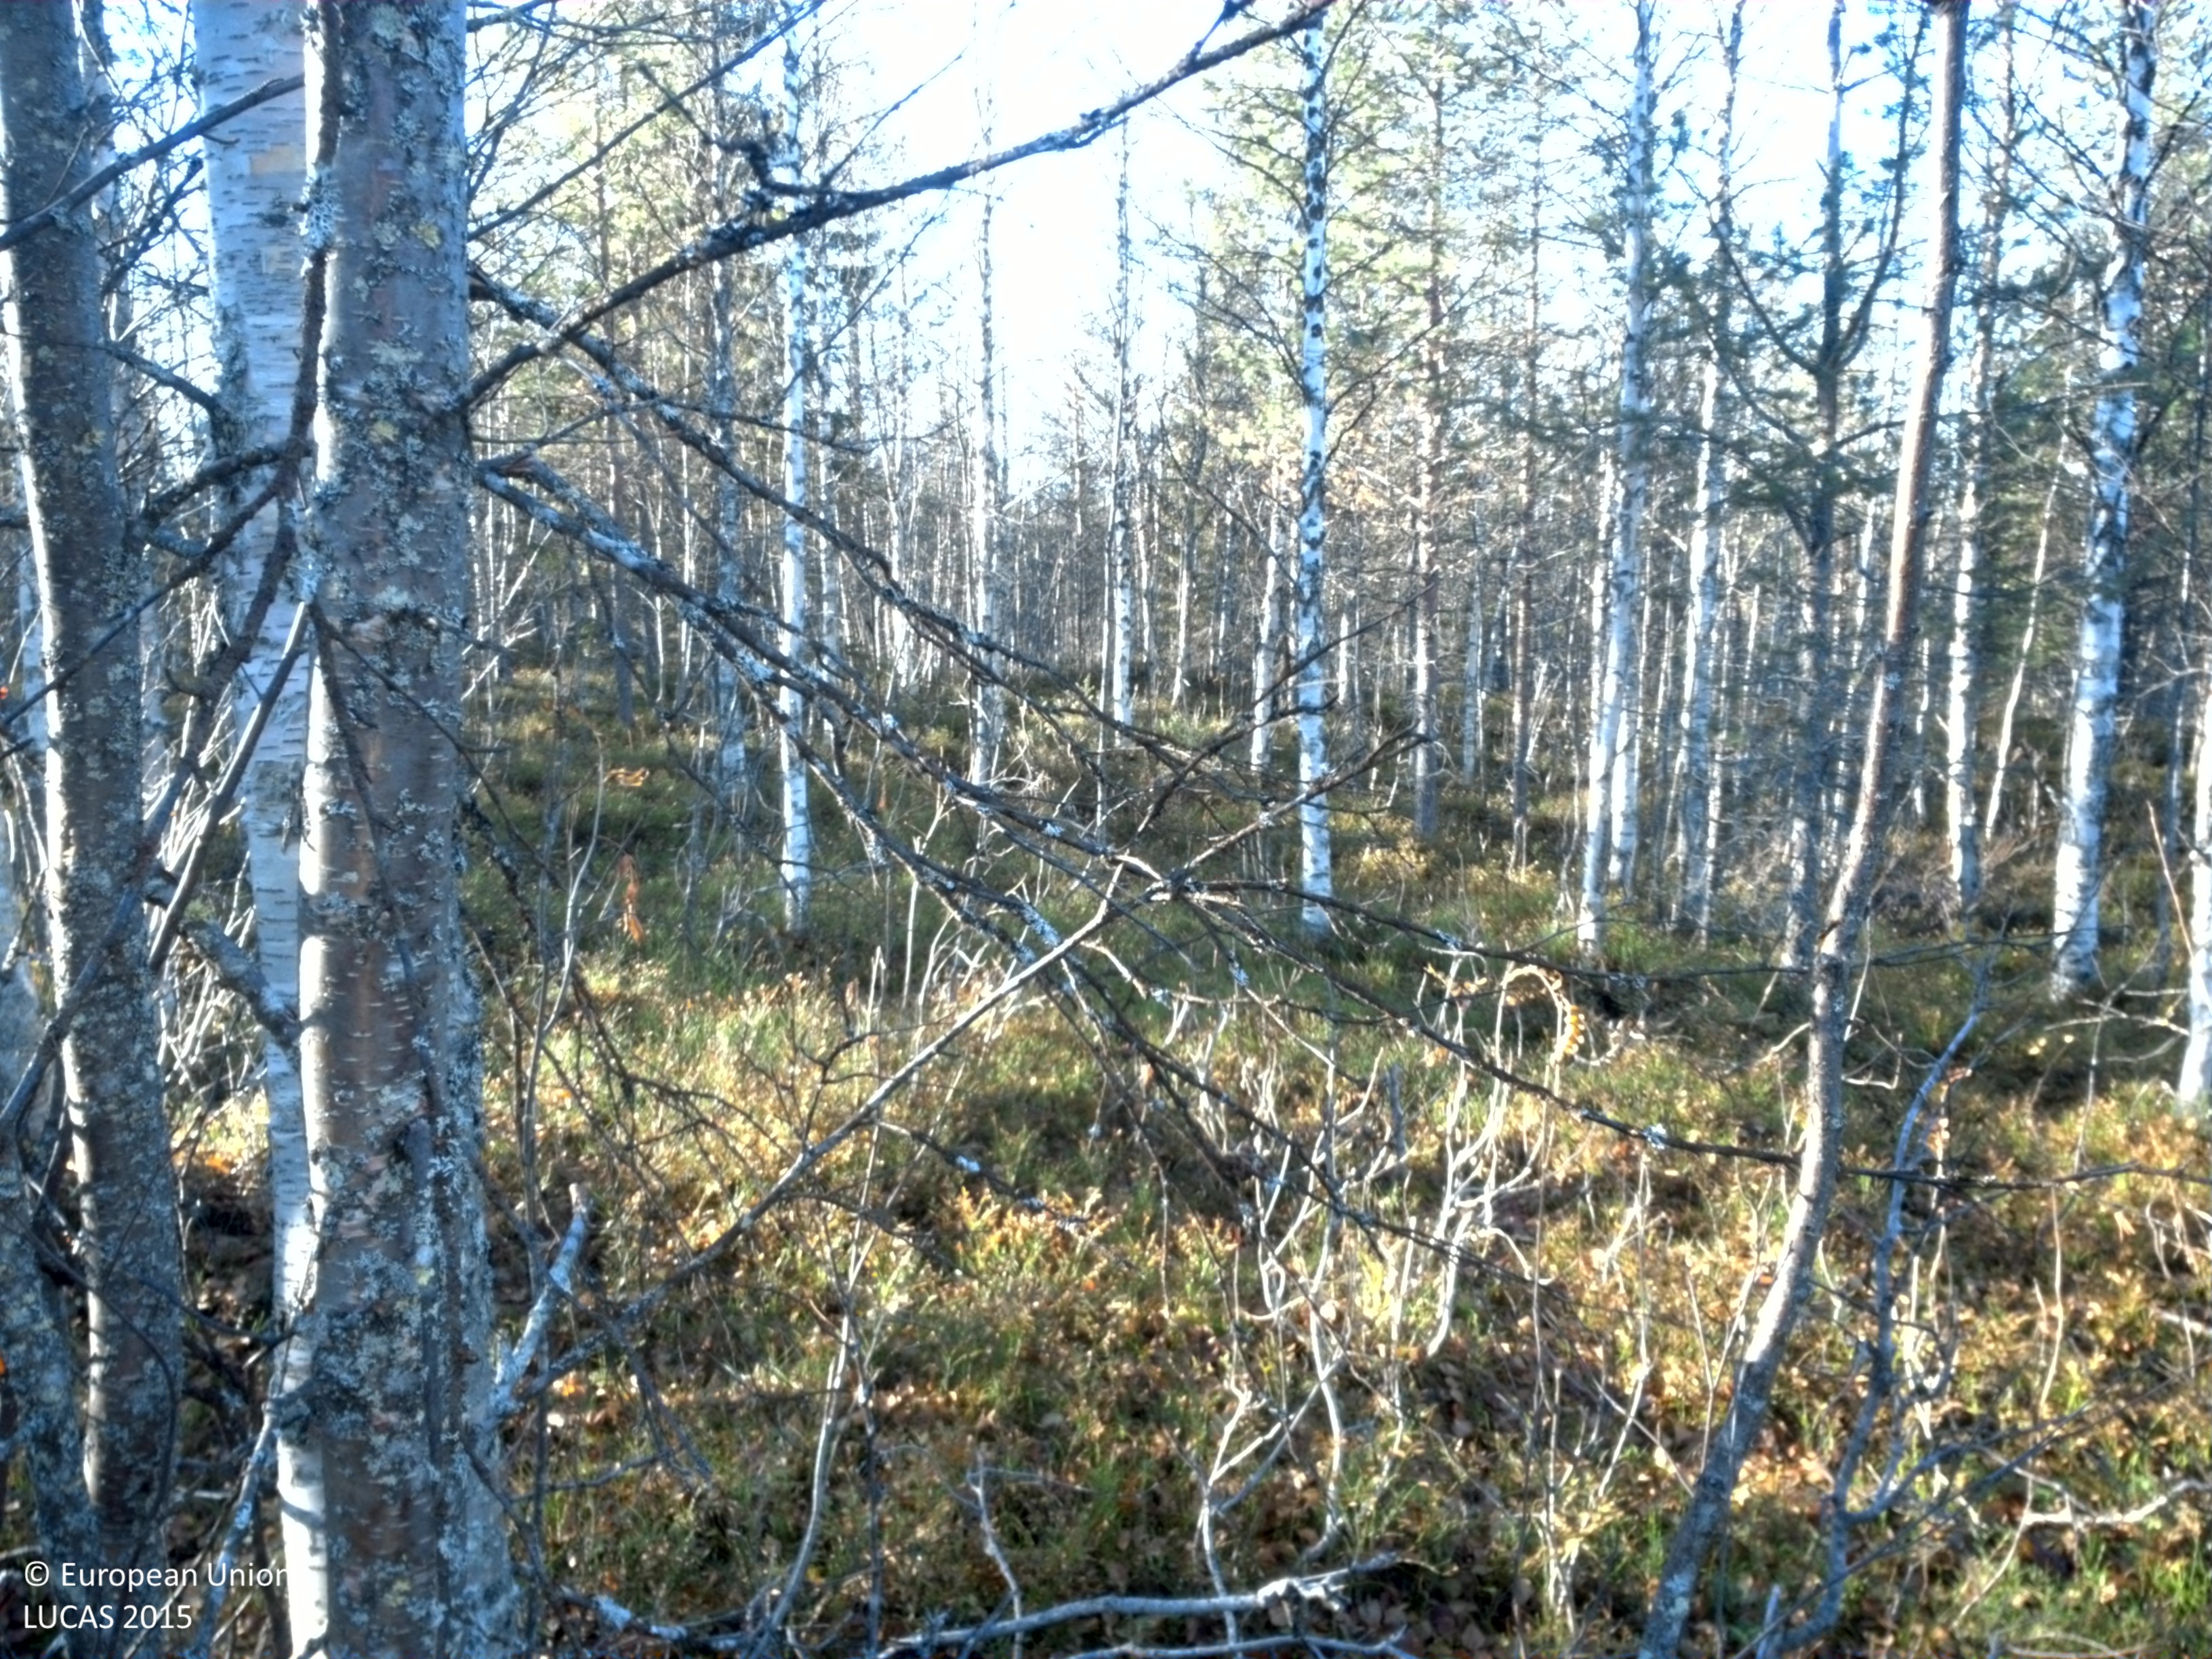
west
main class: Woodland
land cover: Broadleaved woodland
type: non-riverine alder, birch or aspen forest
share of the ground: 25 - 50 %
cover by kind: shrubs 40 %, broadleaved forest trees 35 %, lichens and mosses 15 %, coniferous forest trees 5 %, herbaceous plants 5 %
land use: Forestry
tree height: > 5 m
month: October
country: SE
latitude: 64.5714
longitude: 16.5423
